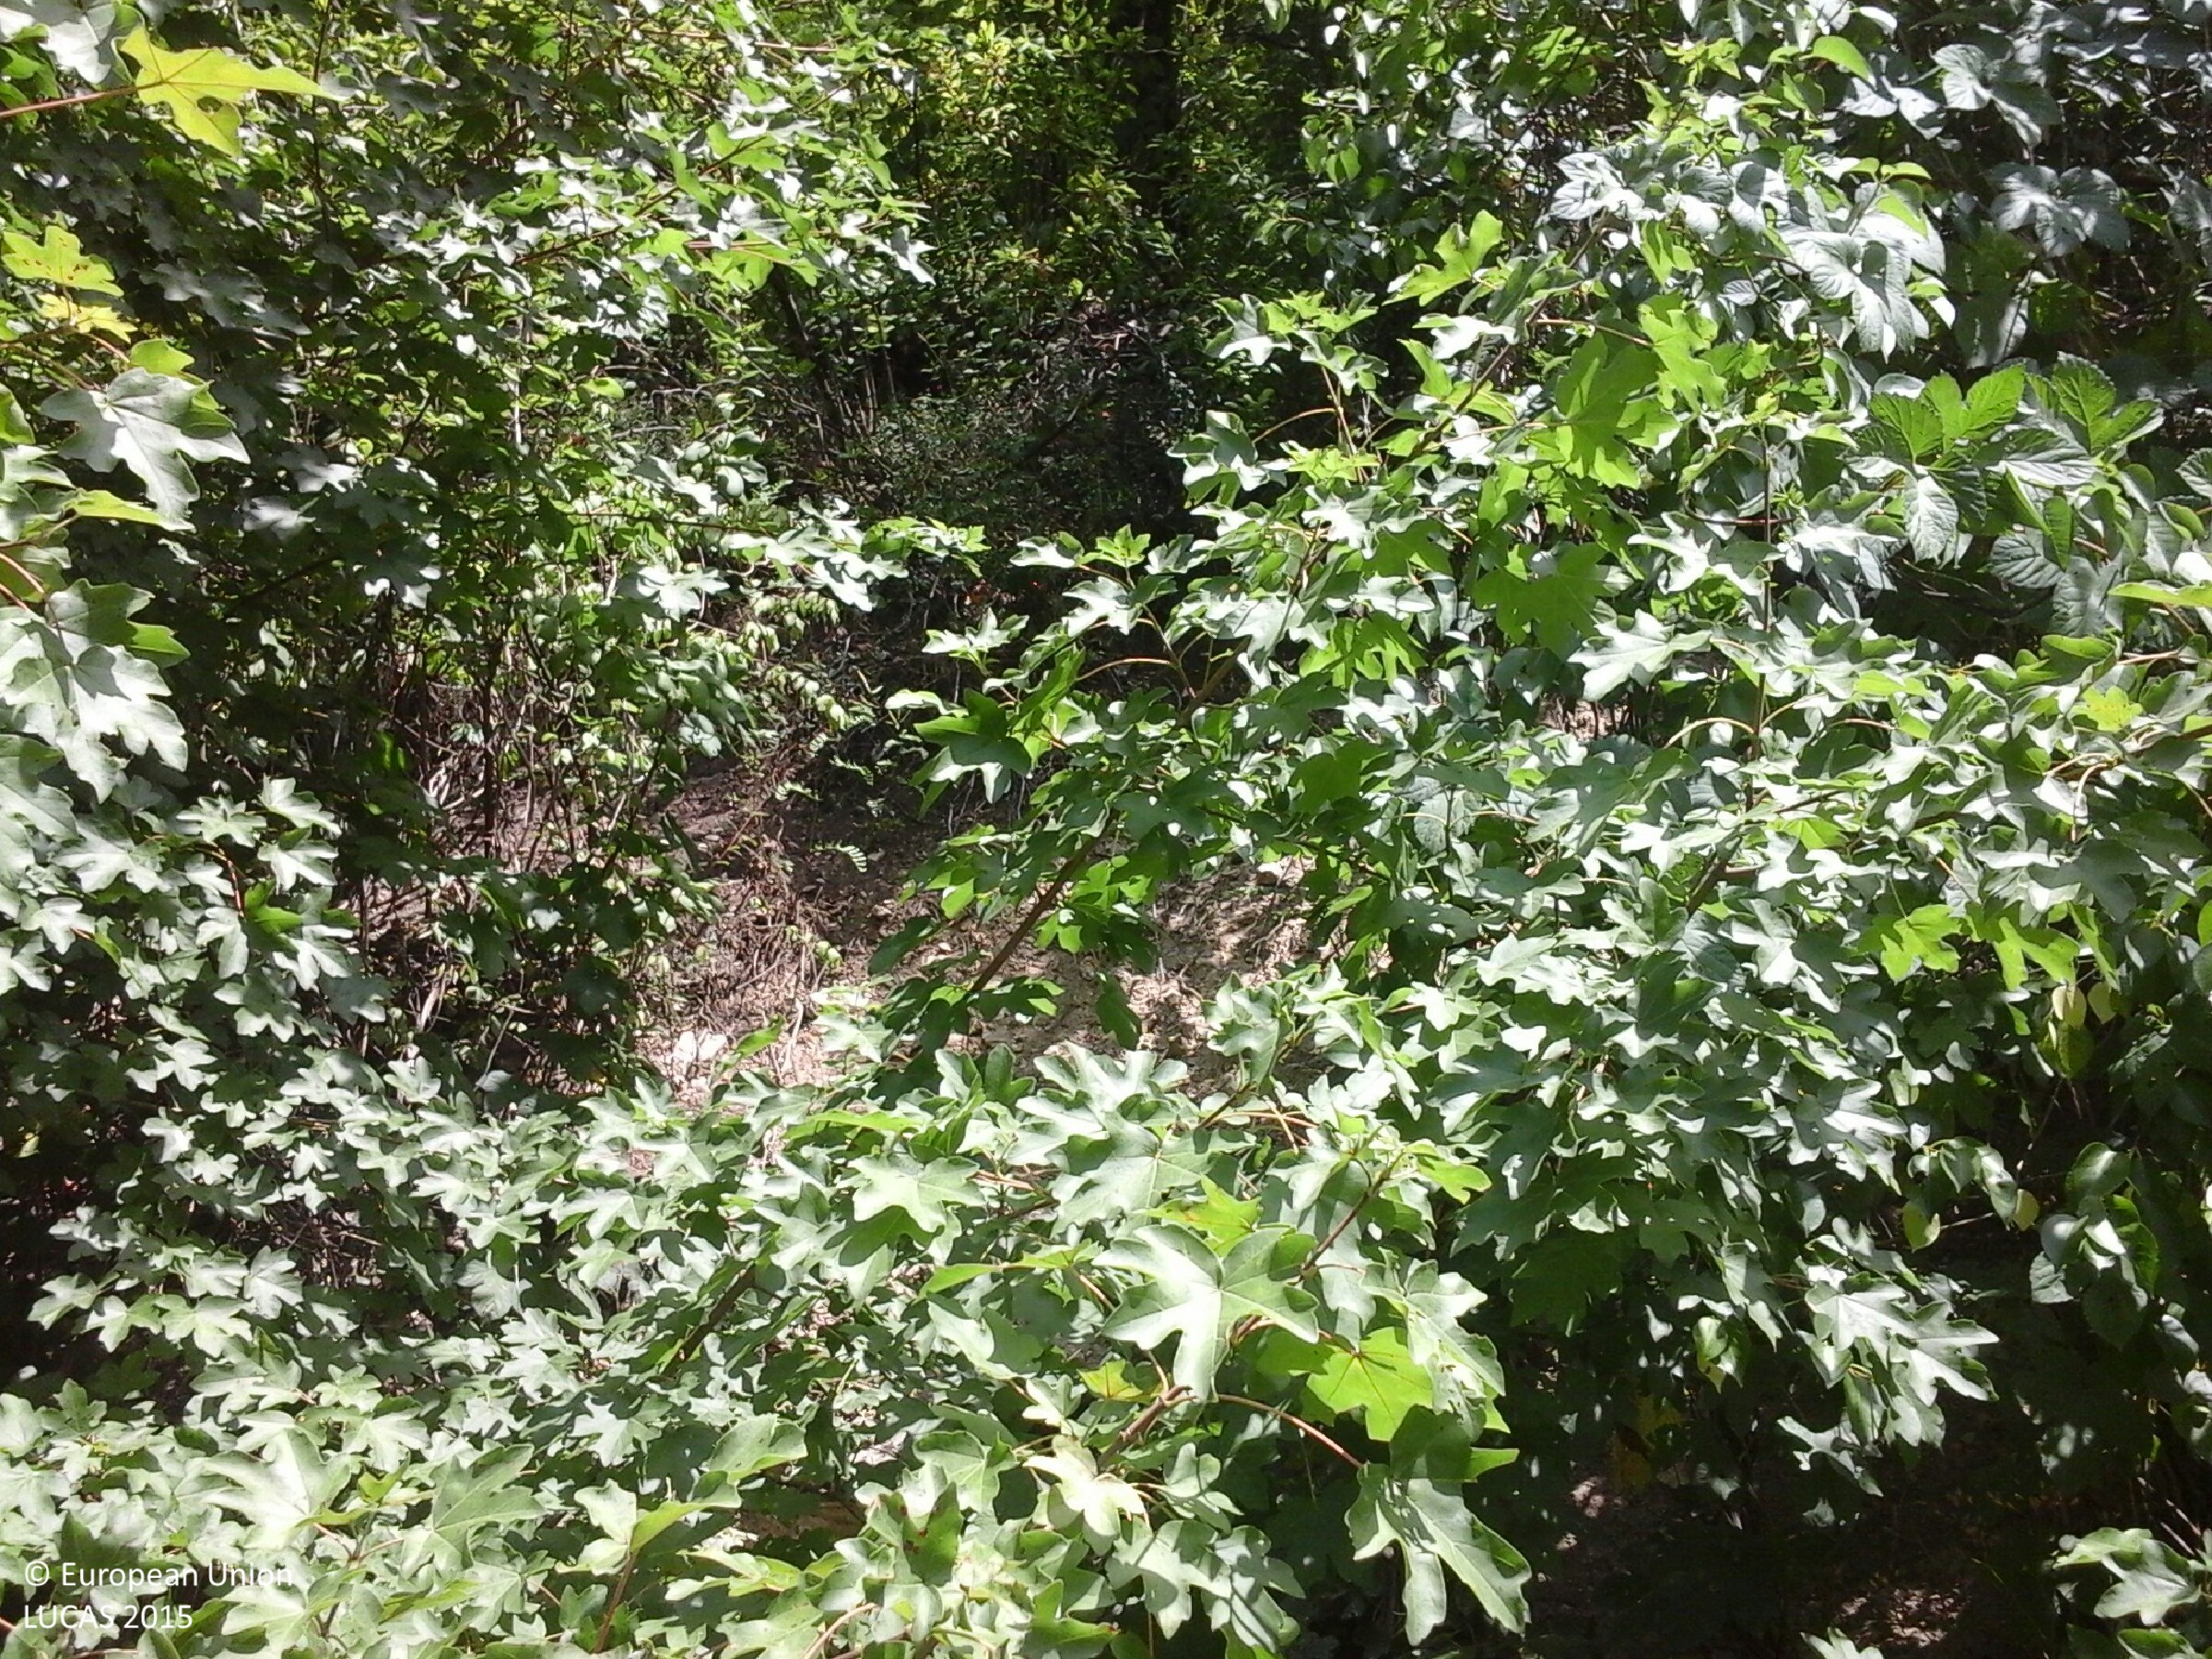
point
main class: Woodland
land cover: Broadleaved woodland
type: mesophytic deciduous forest
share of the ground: > 75 %
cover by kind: broadleaved forest trees 75 %, shrubs 20 %, herbaceous plants 5 %
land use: Forestry
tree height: > 5 m
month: July
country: HU
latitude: 48.1072
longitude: 20.6315
